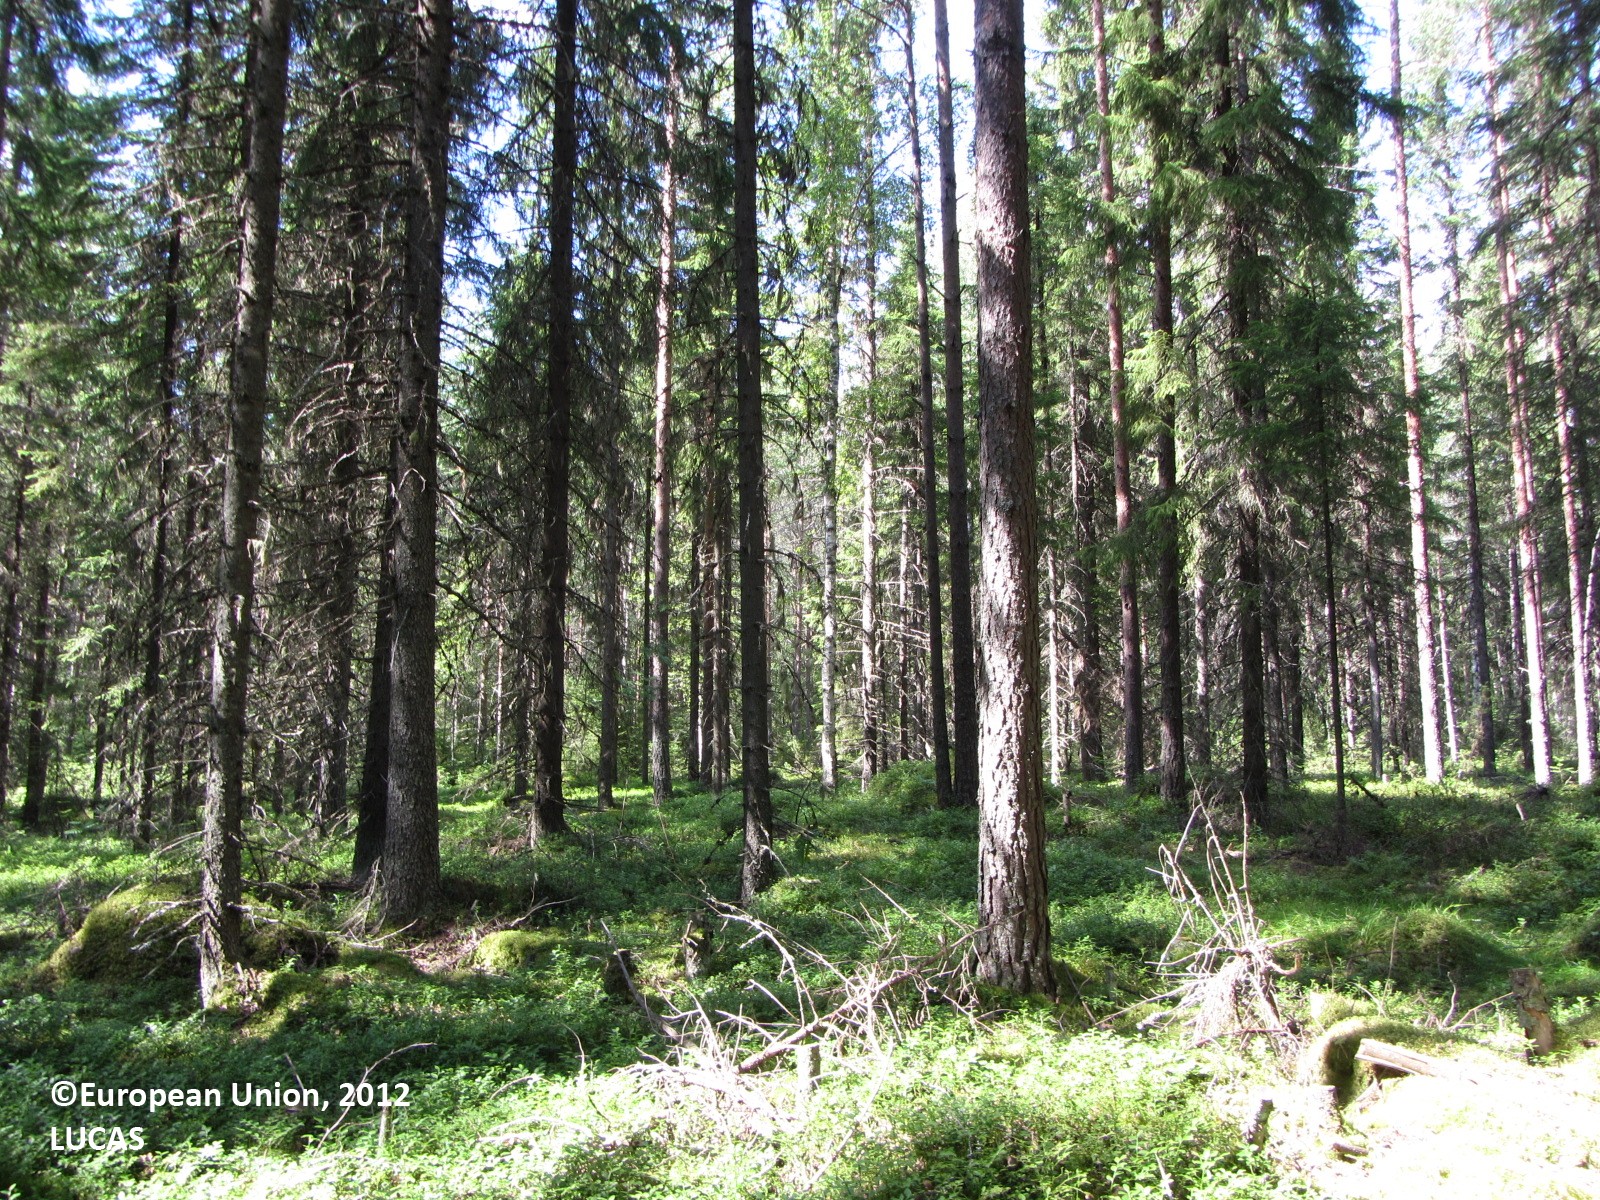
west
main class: Woodland
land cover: Spruce dominated coniferous woodland
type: boreal forest
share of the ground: > 75 %
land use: Forestry
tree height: > 5 m
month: July
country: FI
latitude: 63.5492
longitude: 24.6305
